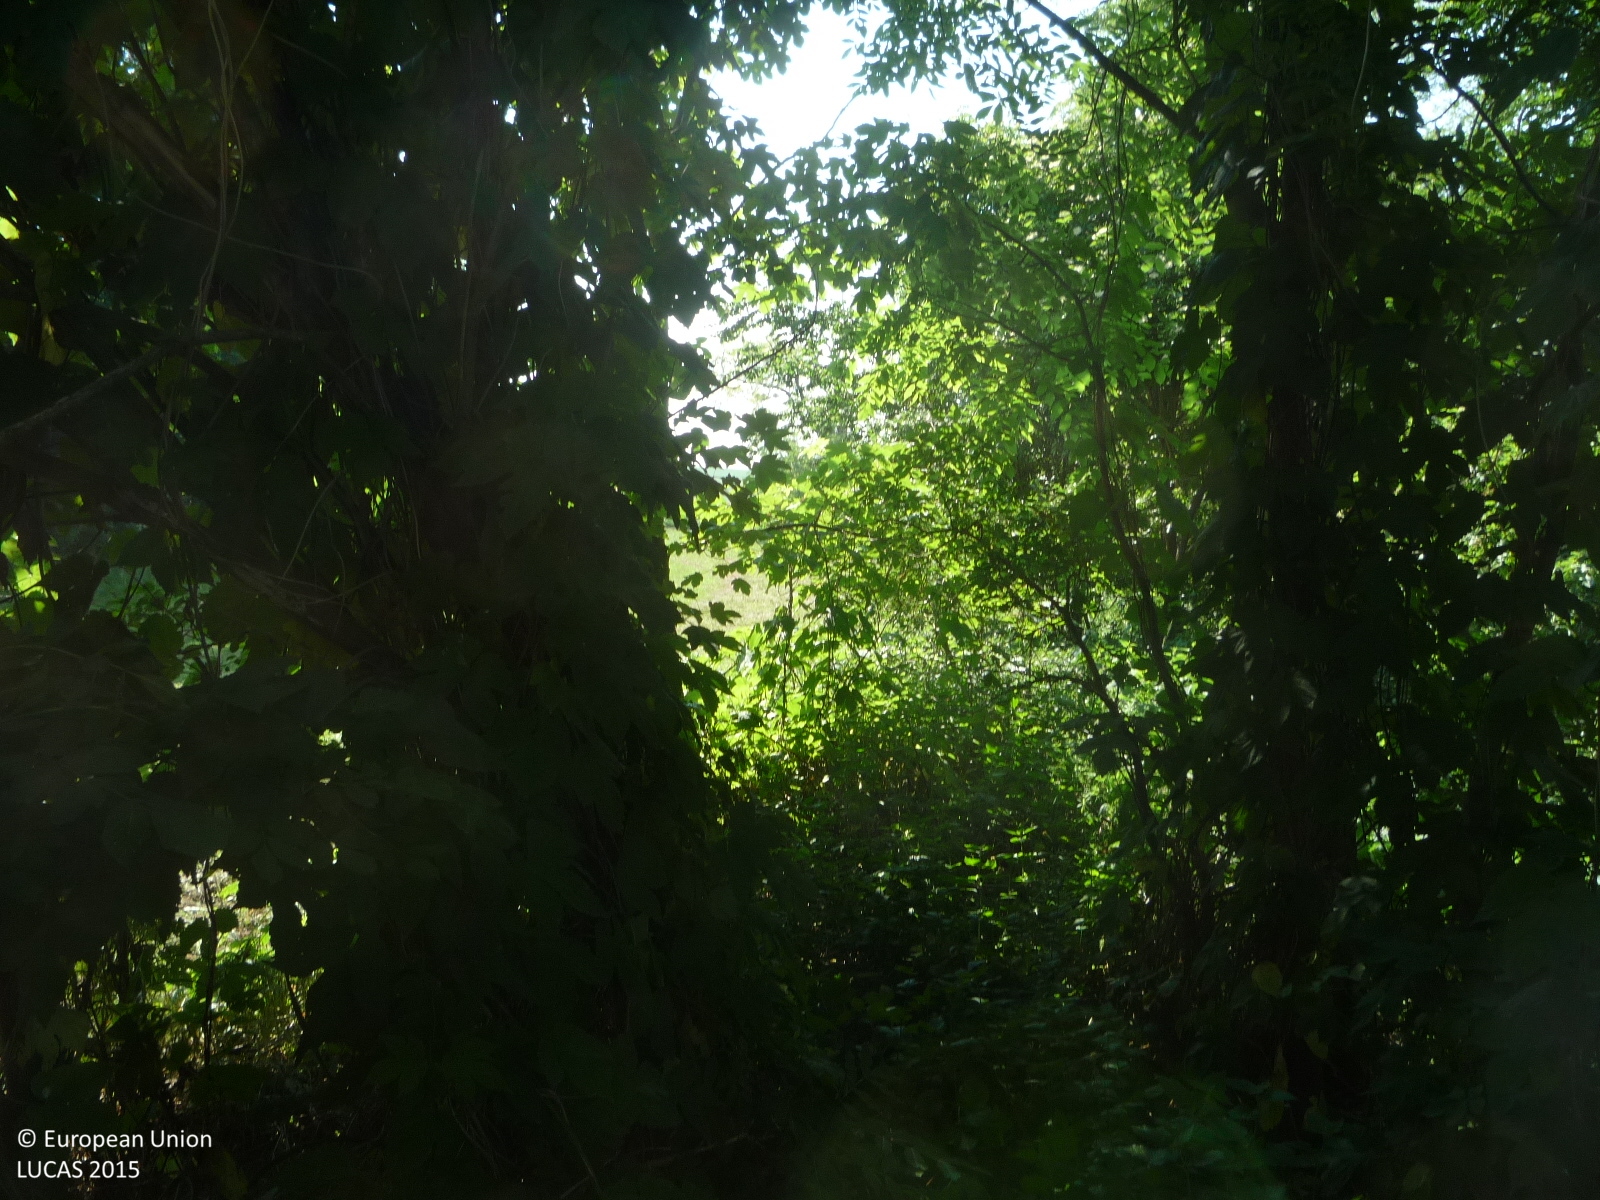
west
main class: Woodland
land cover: Broadleaved woodland
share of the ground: > 75 %
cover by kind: broadleaved forest trees 90 %, shrubs 5 %, herbaceous plants 5 %
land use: Semi-natural and natural areas not in use
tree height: > 5 m
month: June
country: CZ
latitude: 50.2163
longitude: 14.1634
